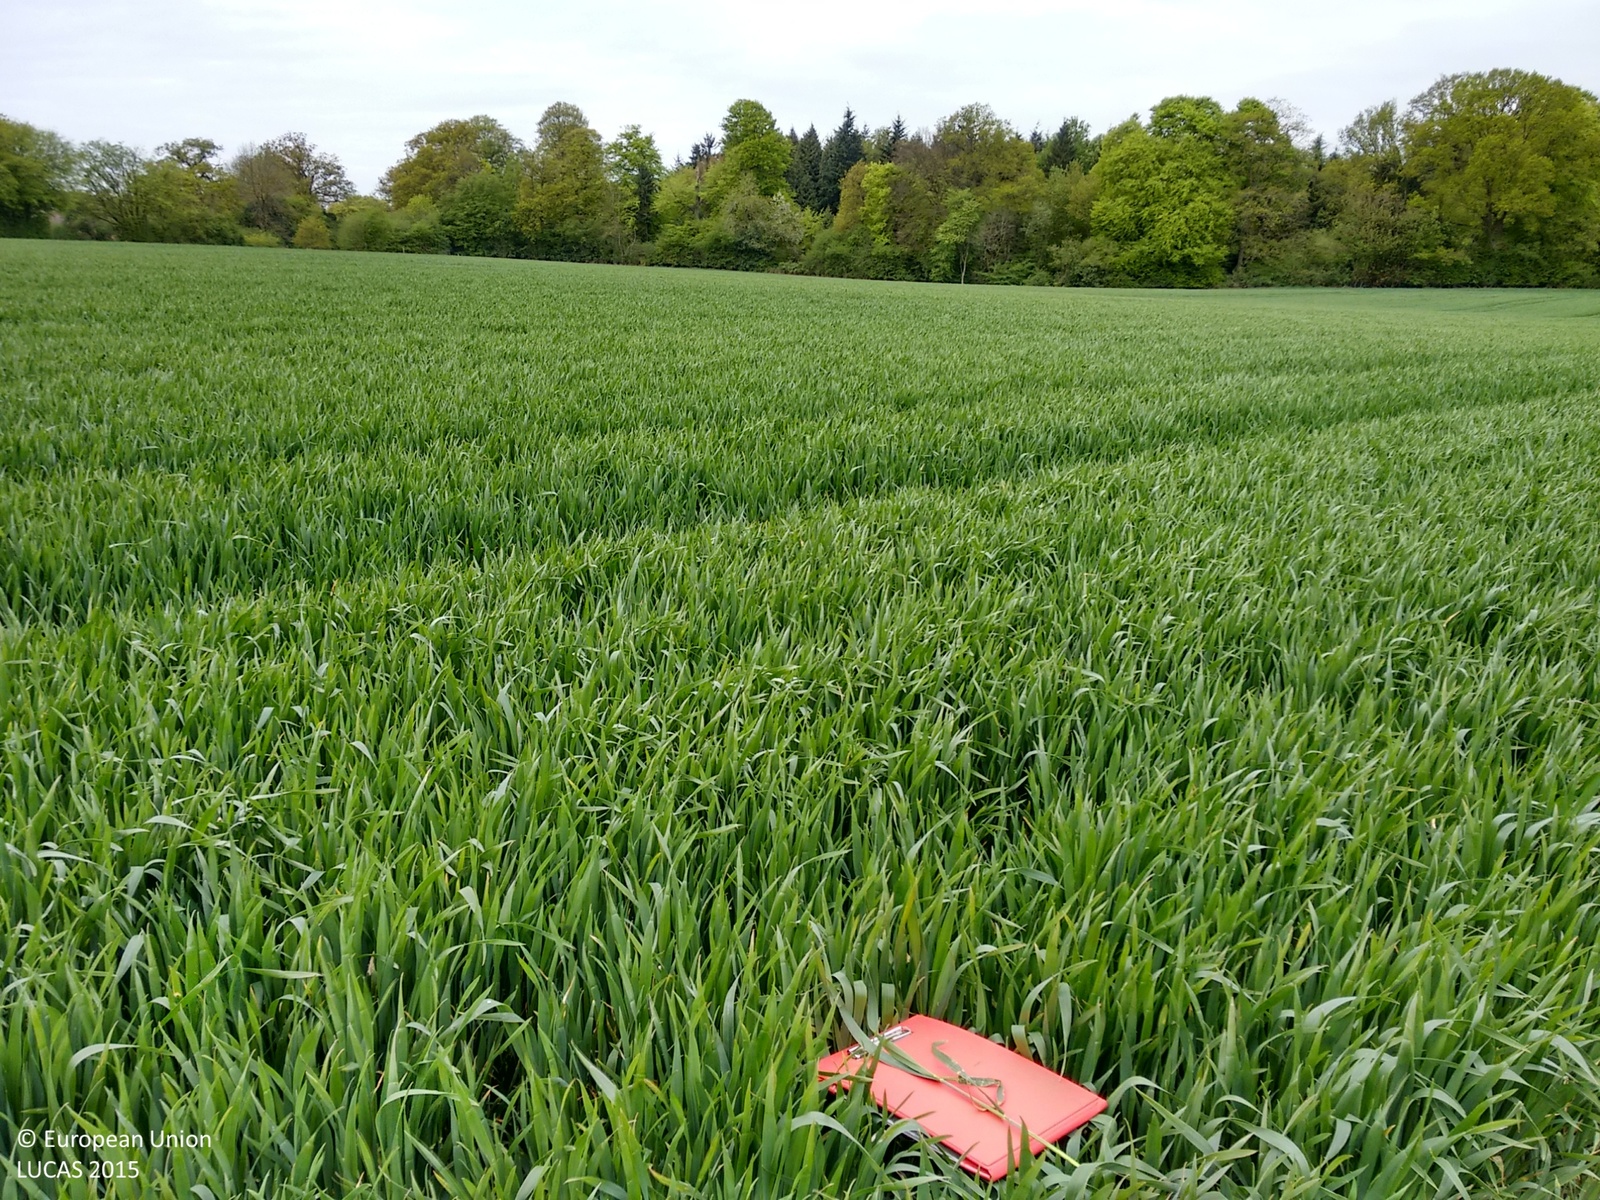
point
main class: Cropland
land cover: Common wheat
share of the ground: > 75 %
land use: Agriculture (excluding fallow land and kitchen gardens)
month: May
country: GB
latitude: 51.7563
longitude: -0.6006
